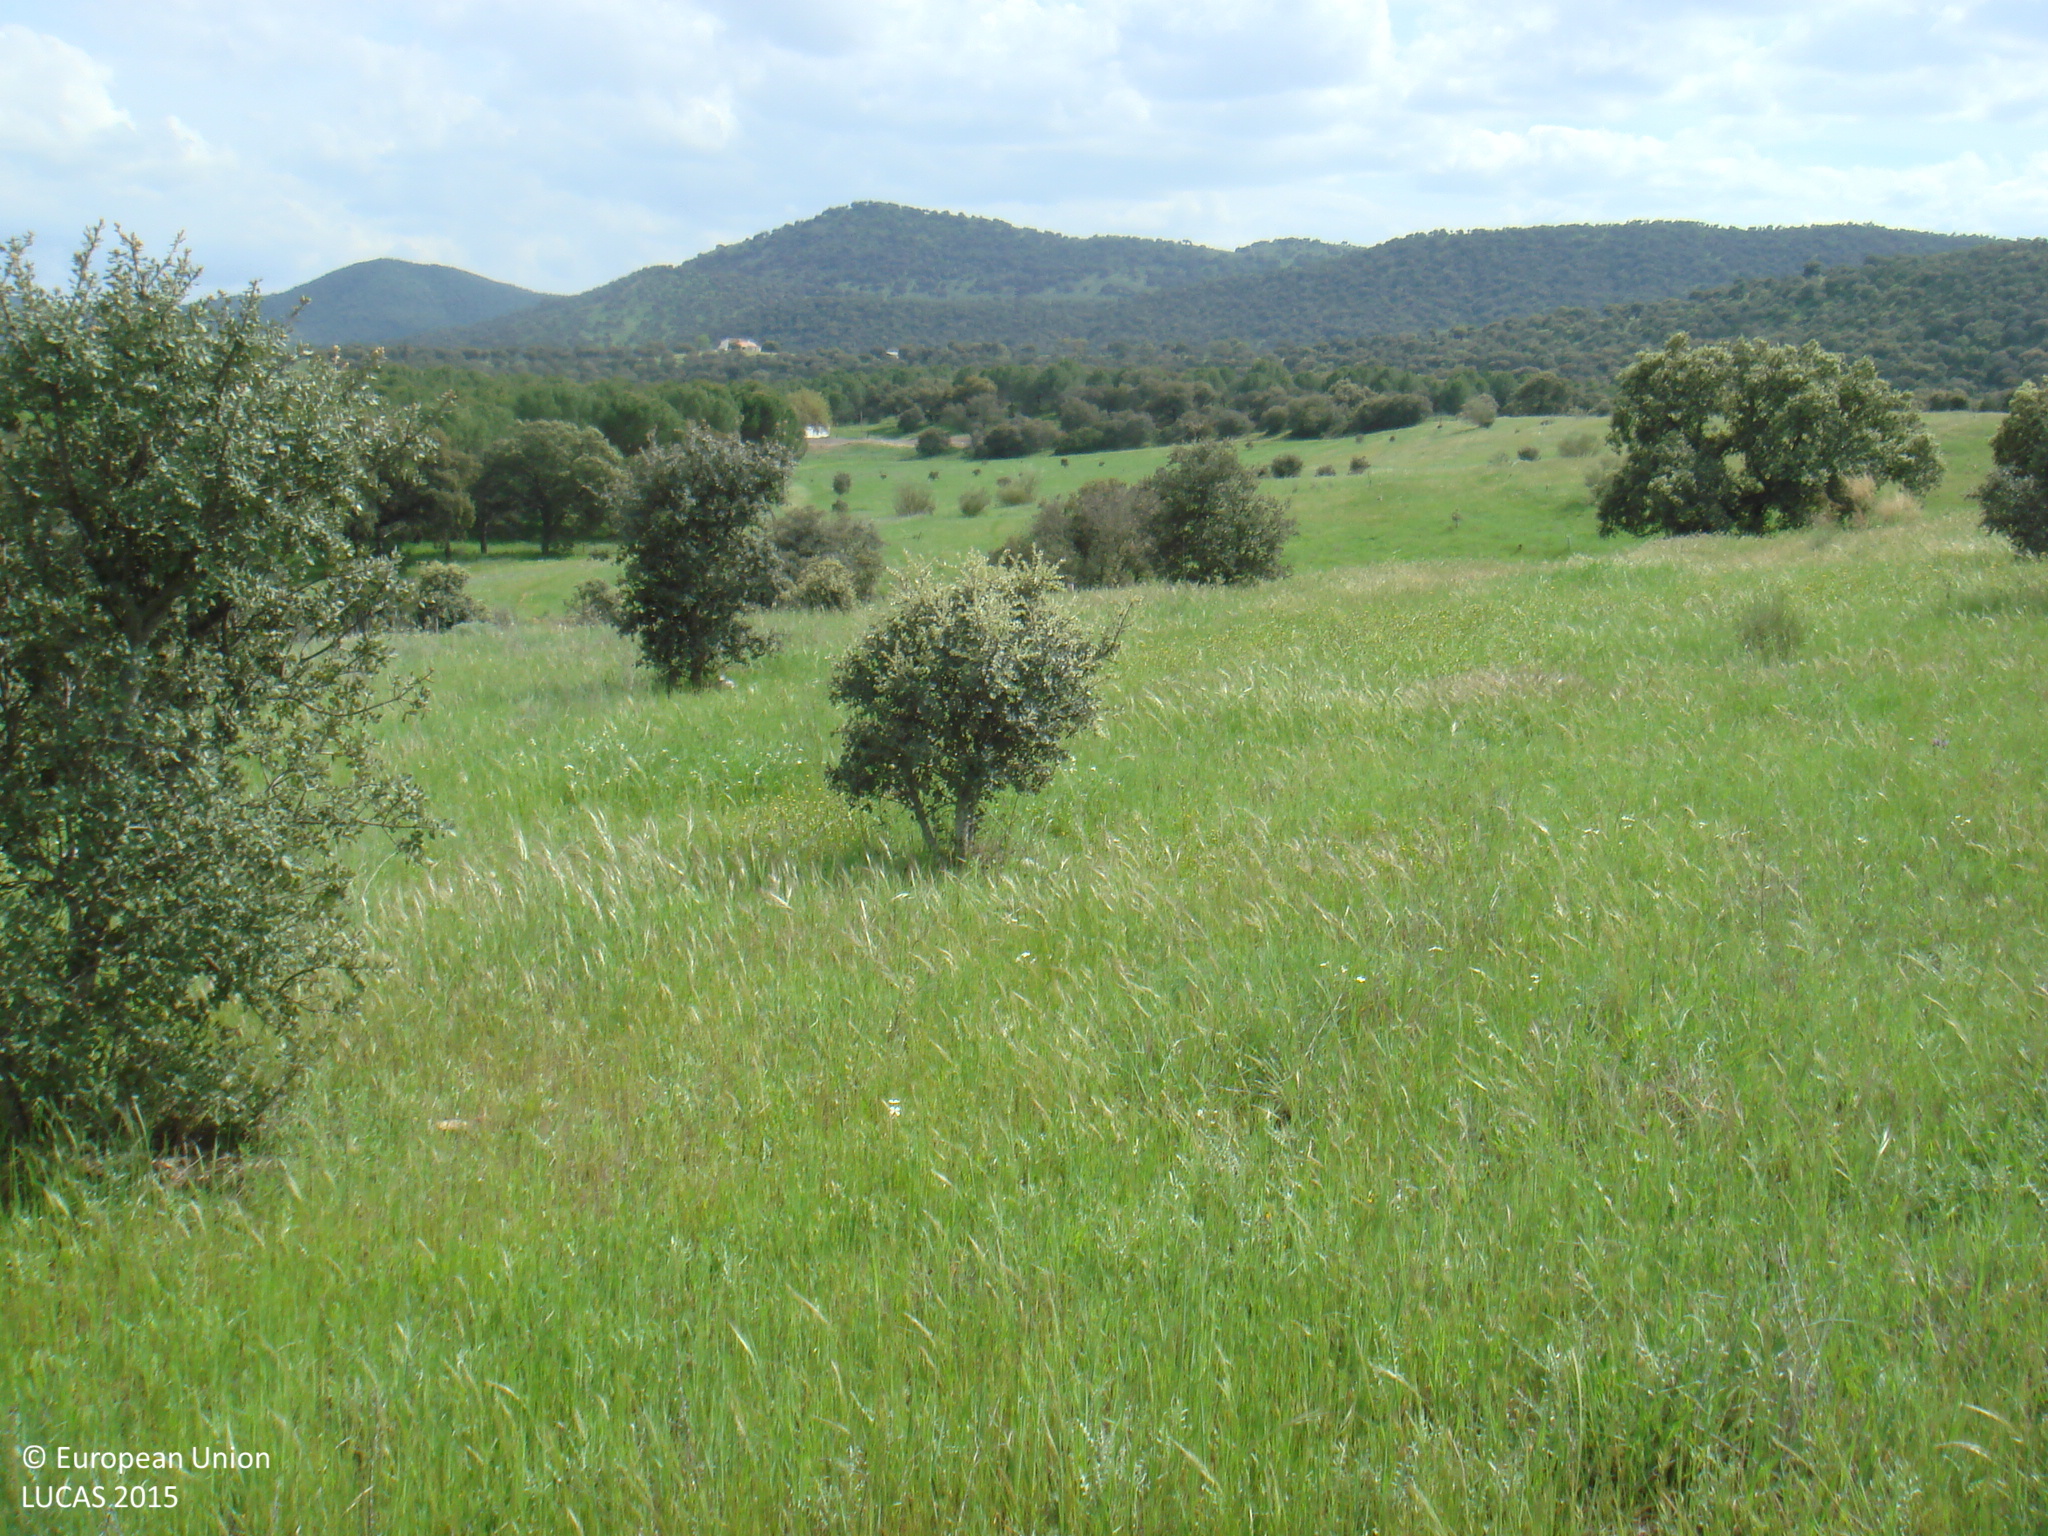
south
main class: Grassland
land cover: Grassland without tree/shrub cover
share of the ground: > 75 %
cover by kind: herbaceous plants 95 %, shrubs 5 %
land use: Agriculture (excluding fallow land and kitchen gardens)
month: April
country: ES
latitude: 38.1965
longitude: -5.0618
